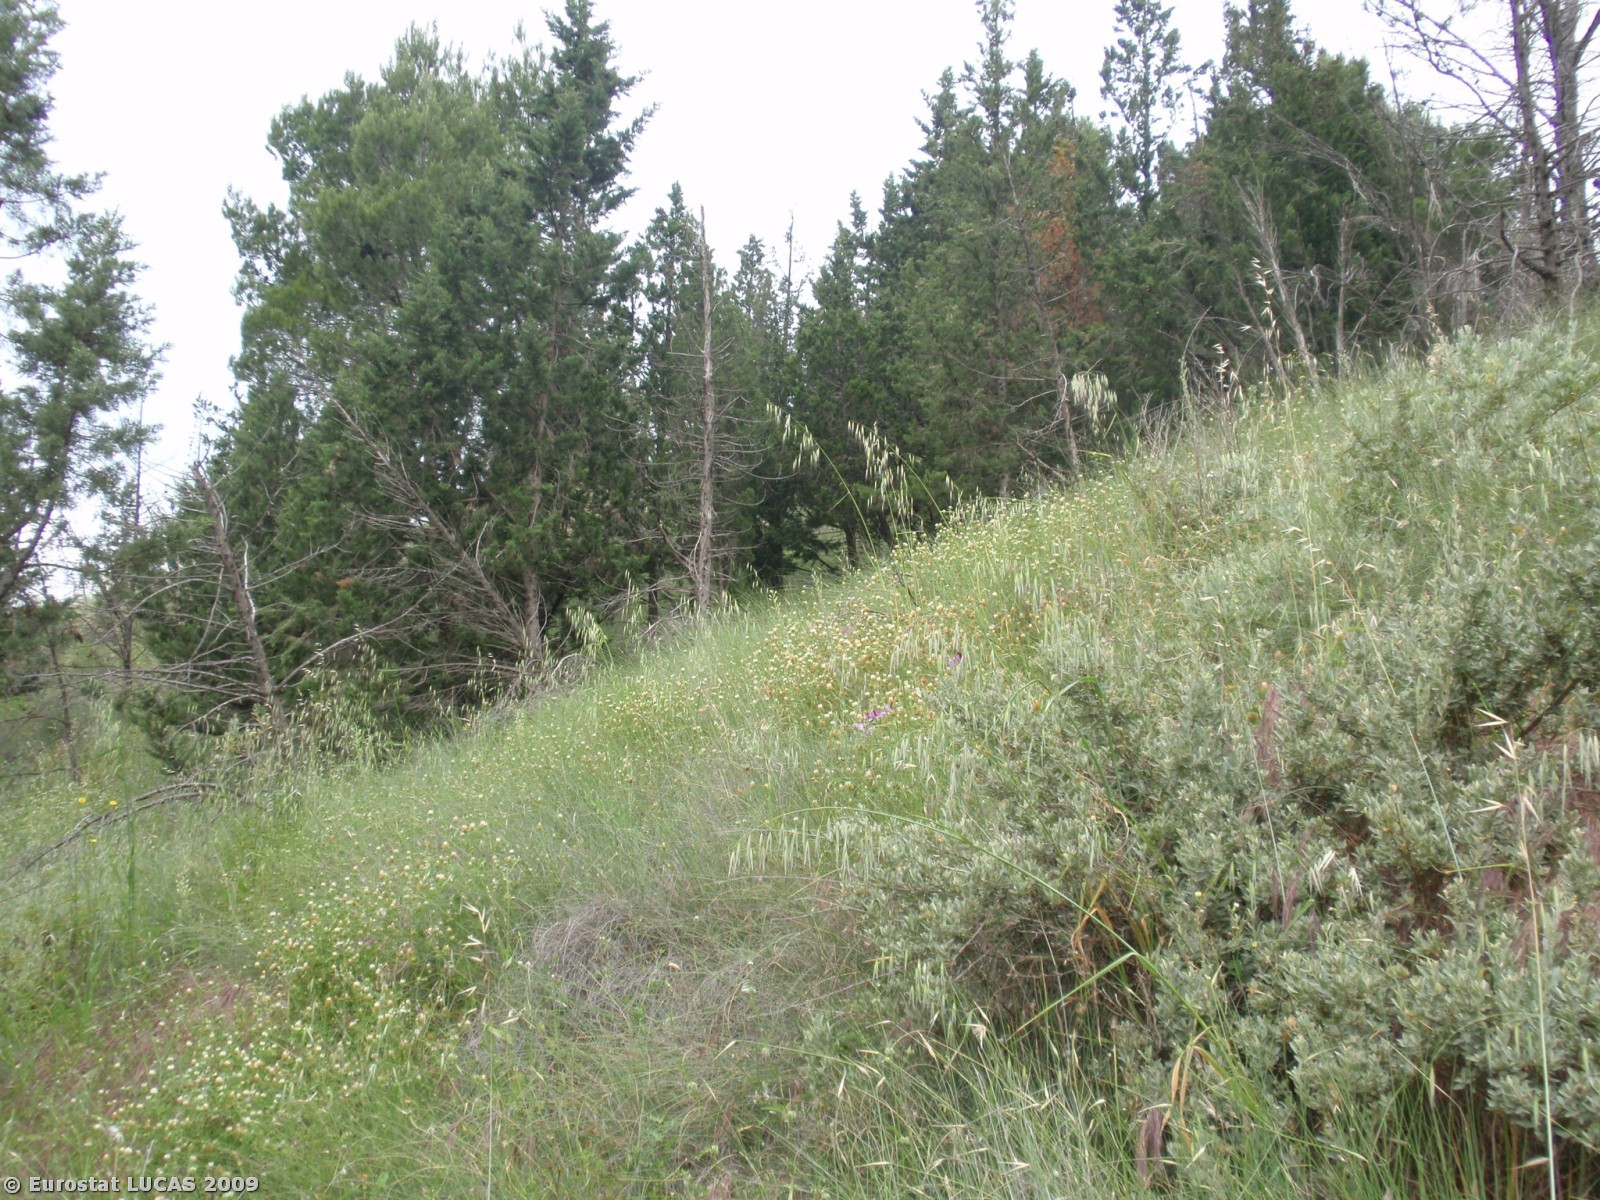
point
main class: Woodland
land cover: Coniferous woodland
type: alpine coniferous forest
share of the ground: > 75 %
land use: Forestry
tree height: > 5 m
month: May
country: IT
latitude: 40.3744
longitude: 16.5591
